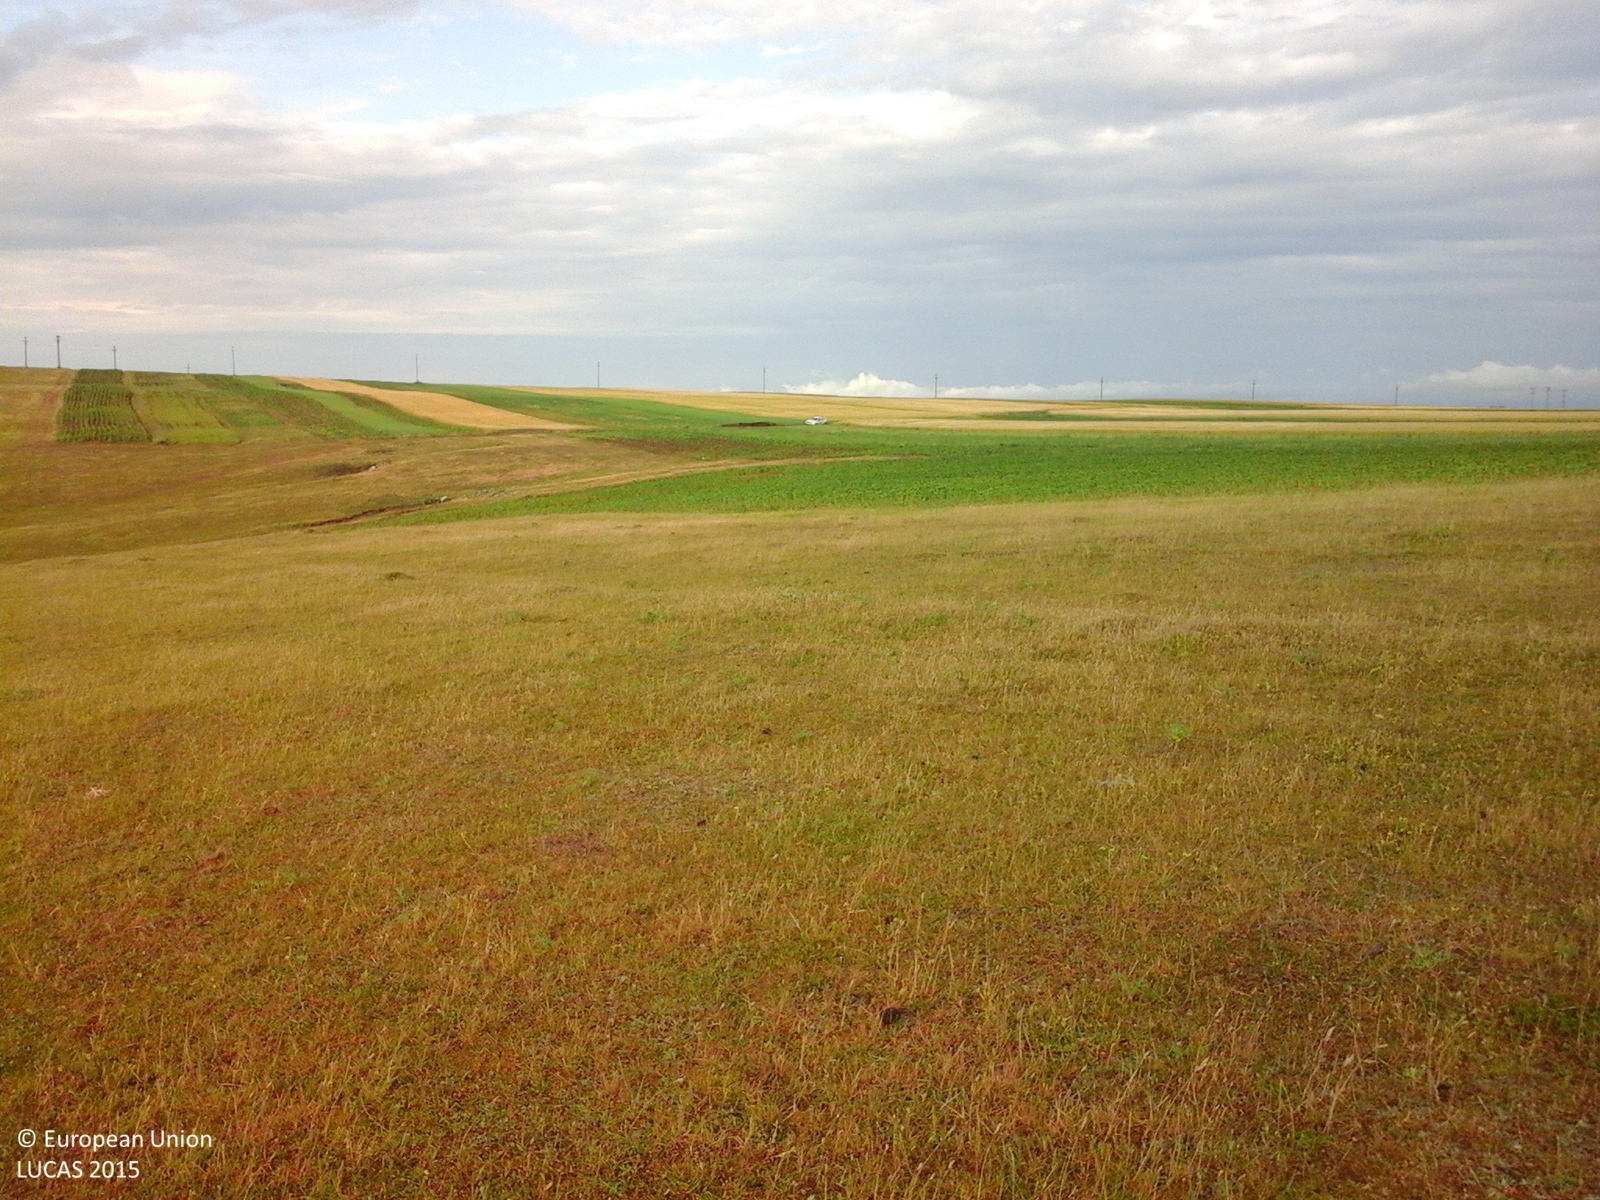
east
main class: Grassland
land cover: Grassland without tree/shrub cover
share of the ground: > 75 %
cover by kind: herbaceous plants 100 %
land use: Agriculture (excluding fallow land and kitchen gardens)
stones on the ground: < 10 %
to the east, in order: Grassland without tree/shrub cover; Sunflower; Grassland without tree/shrub cover; Maize; Rape and turnip rape; Rye
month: June
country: RO
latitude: 47.2510
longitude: 26.8104
